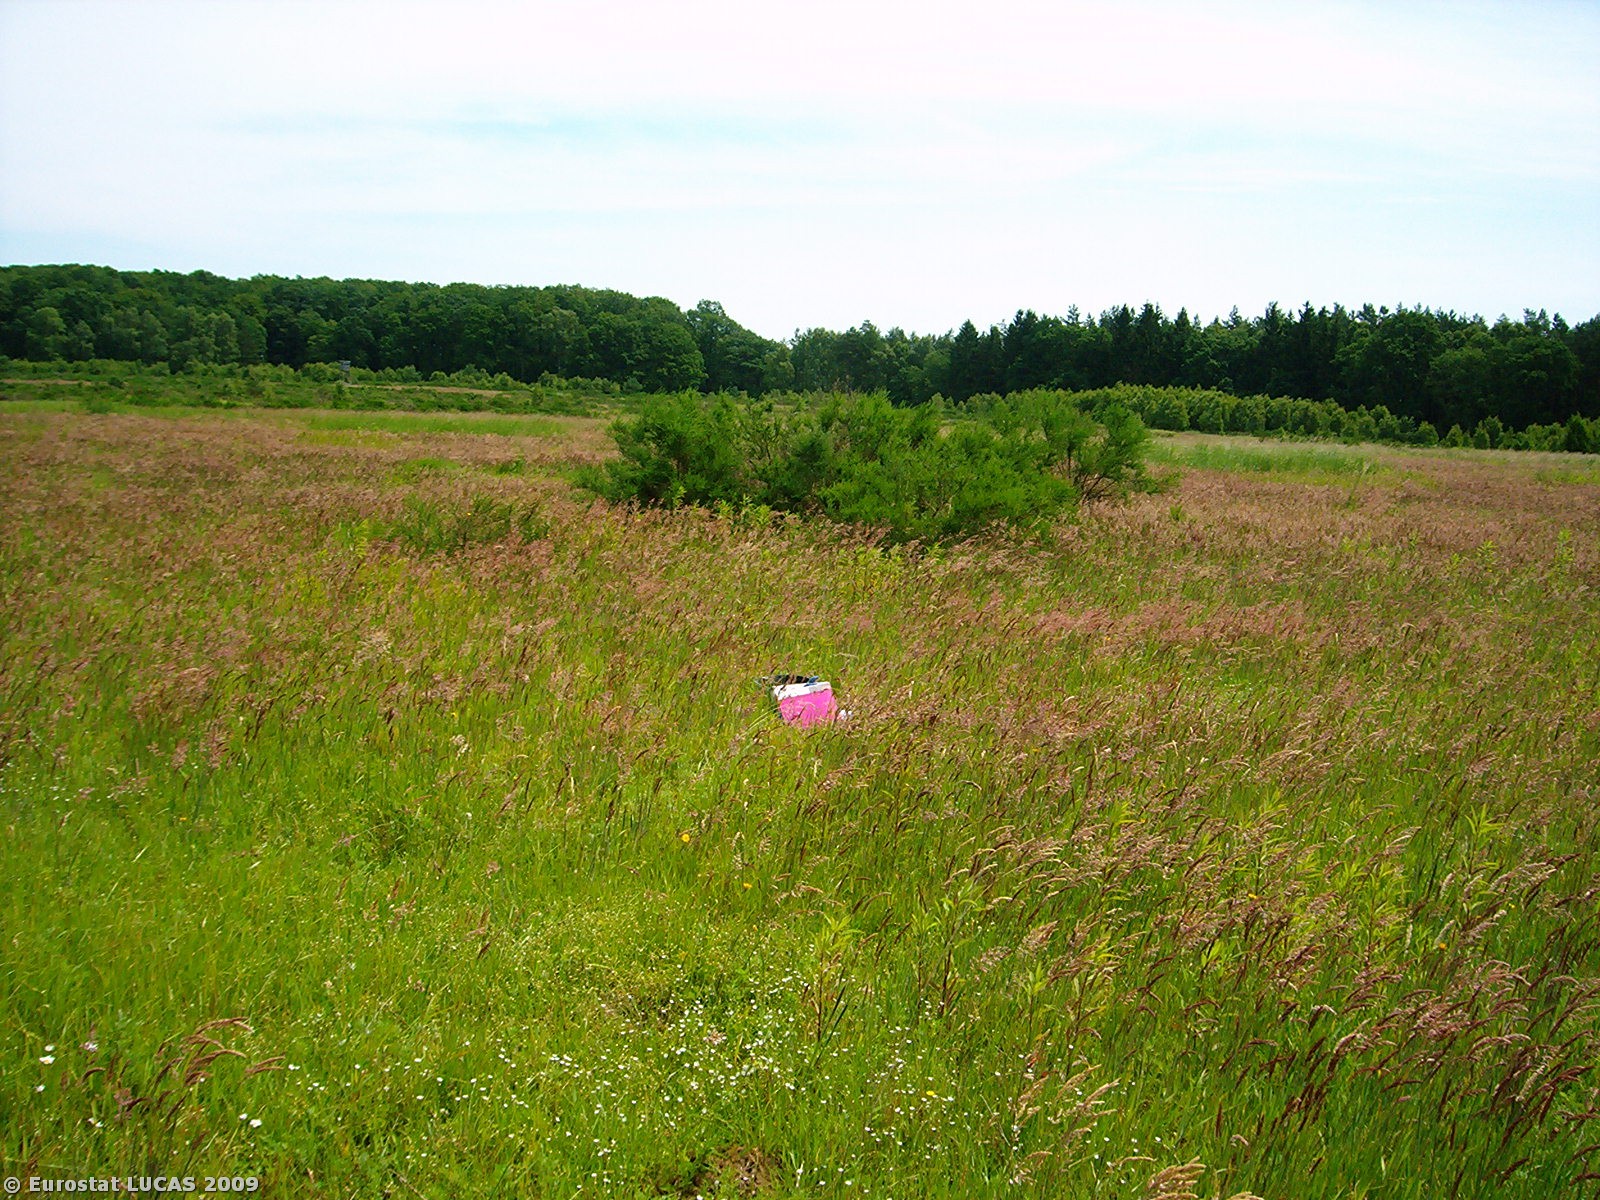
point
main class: Grassland
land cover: Grassland with sparse tree/shrub cover
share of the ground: > 75 %
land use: Unused
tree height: < 5 m
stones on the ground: < 10 %
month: June
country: PL
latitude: 53.8361
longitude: 15.4888
